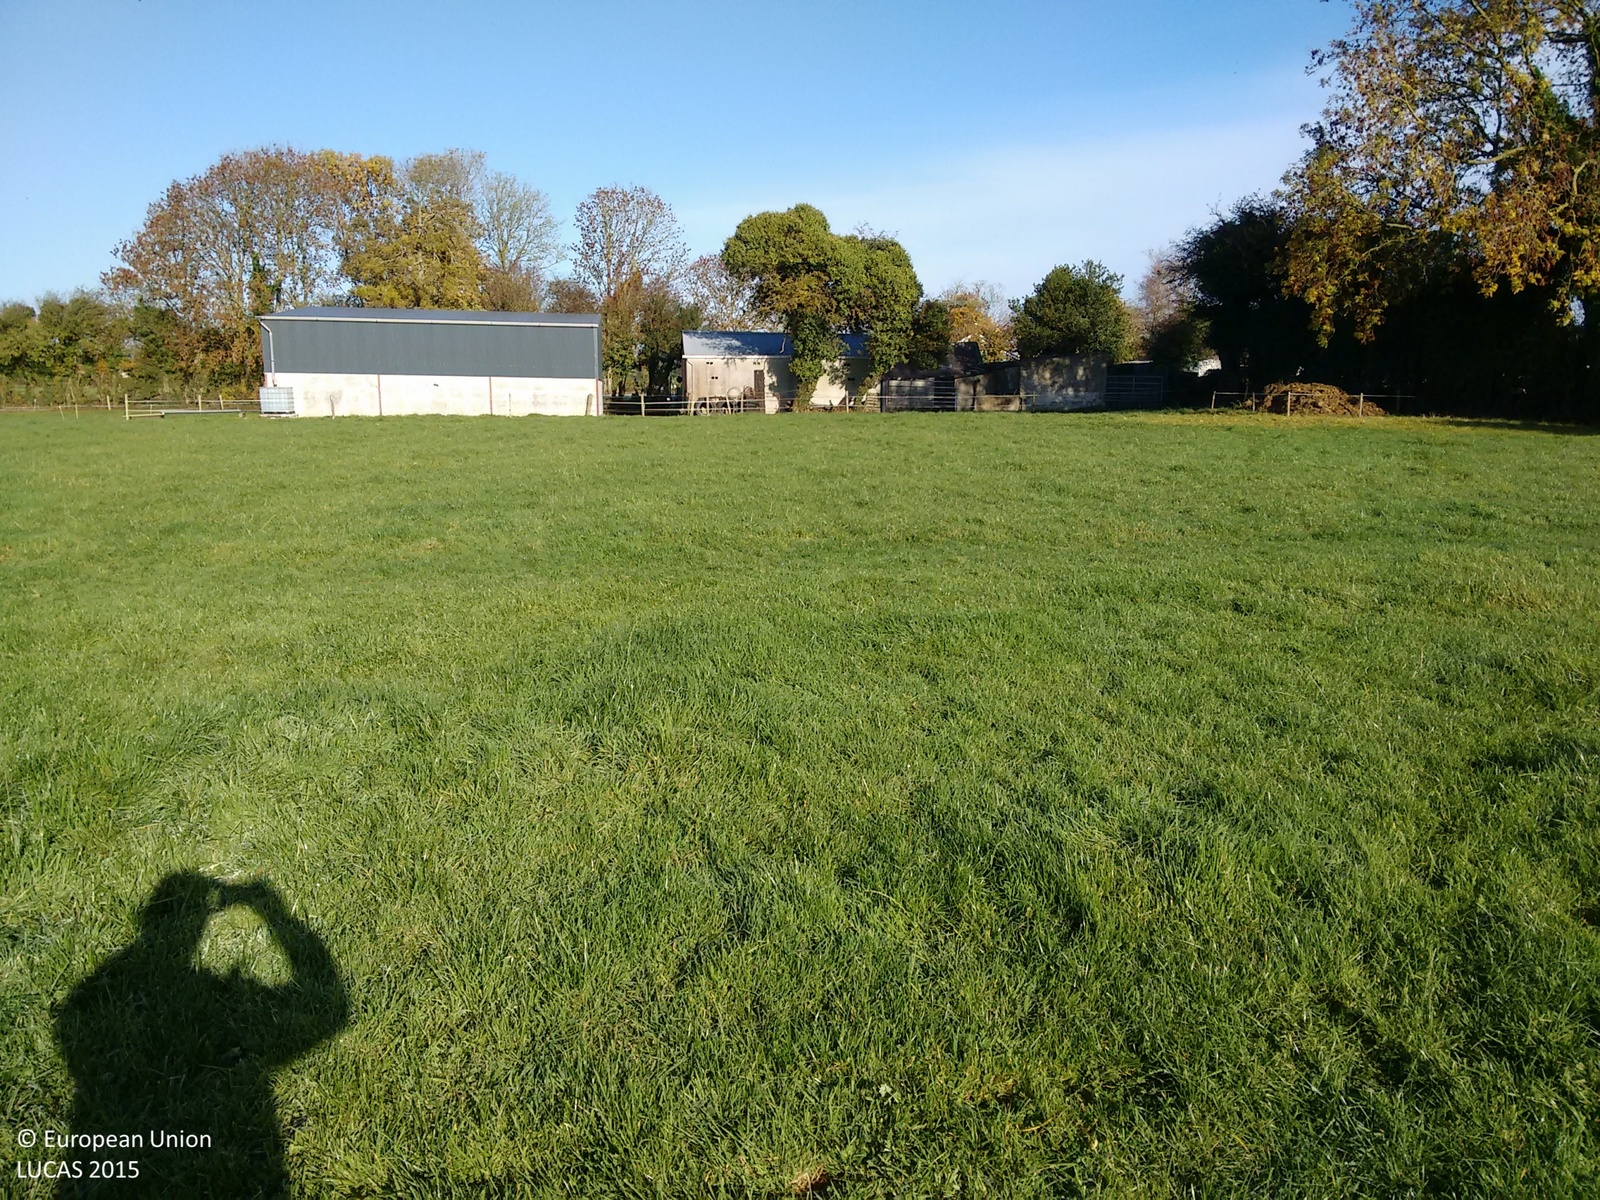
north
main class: Grassland
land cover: Grassland without tree/shrub cover
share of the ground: > 75 %
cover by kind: herbaceous plants 100 %
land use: Agriculture (excluding fallow land and kitchen gardens)
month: October
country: IE
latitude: 53.2855
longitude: -7.5446
